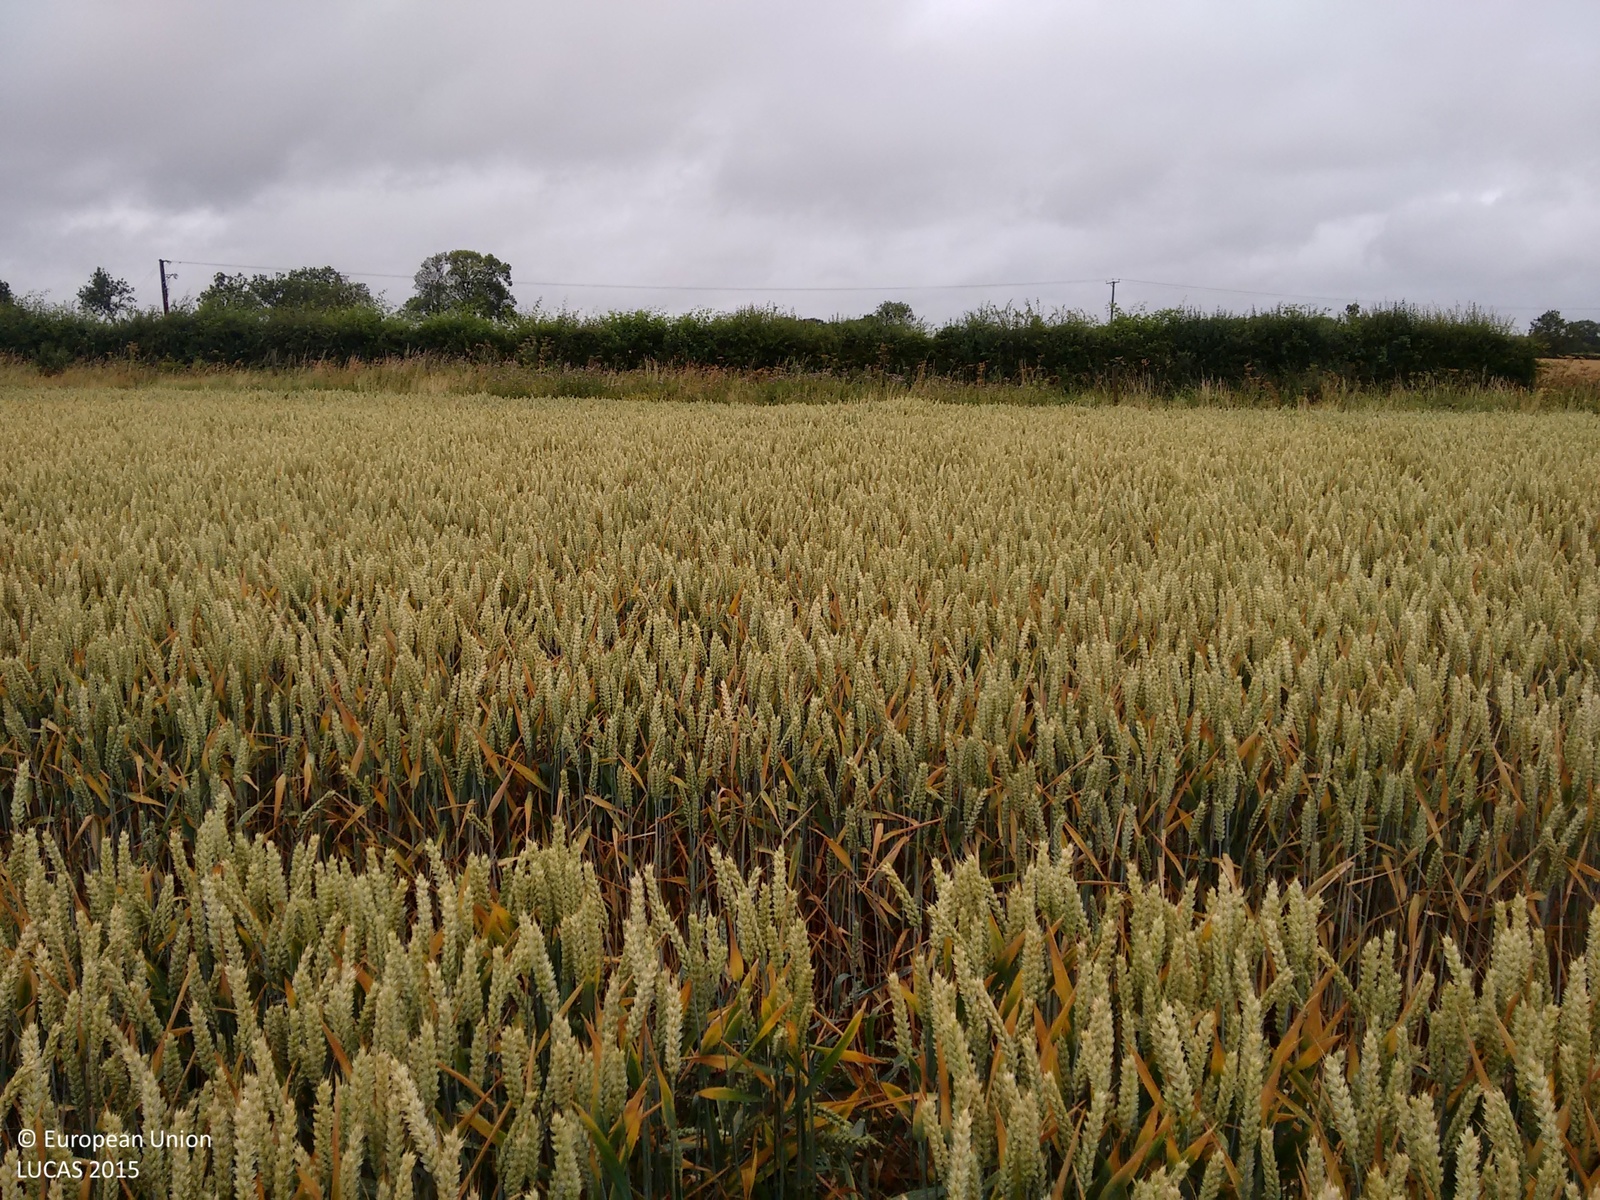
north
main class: Cropland
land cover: Common wheat
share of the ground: > 75 %
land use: Agriculture (excluding fallow land and kitchen gardens)
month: July
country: GB
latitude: 52.5002
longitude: -0.3926
